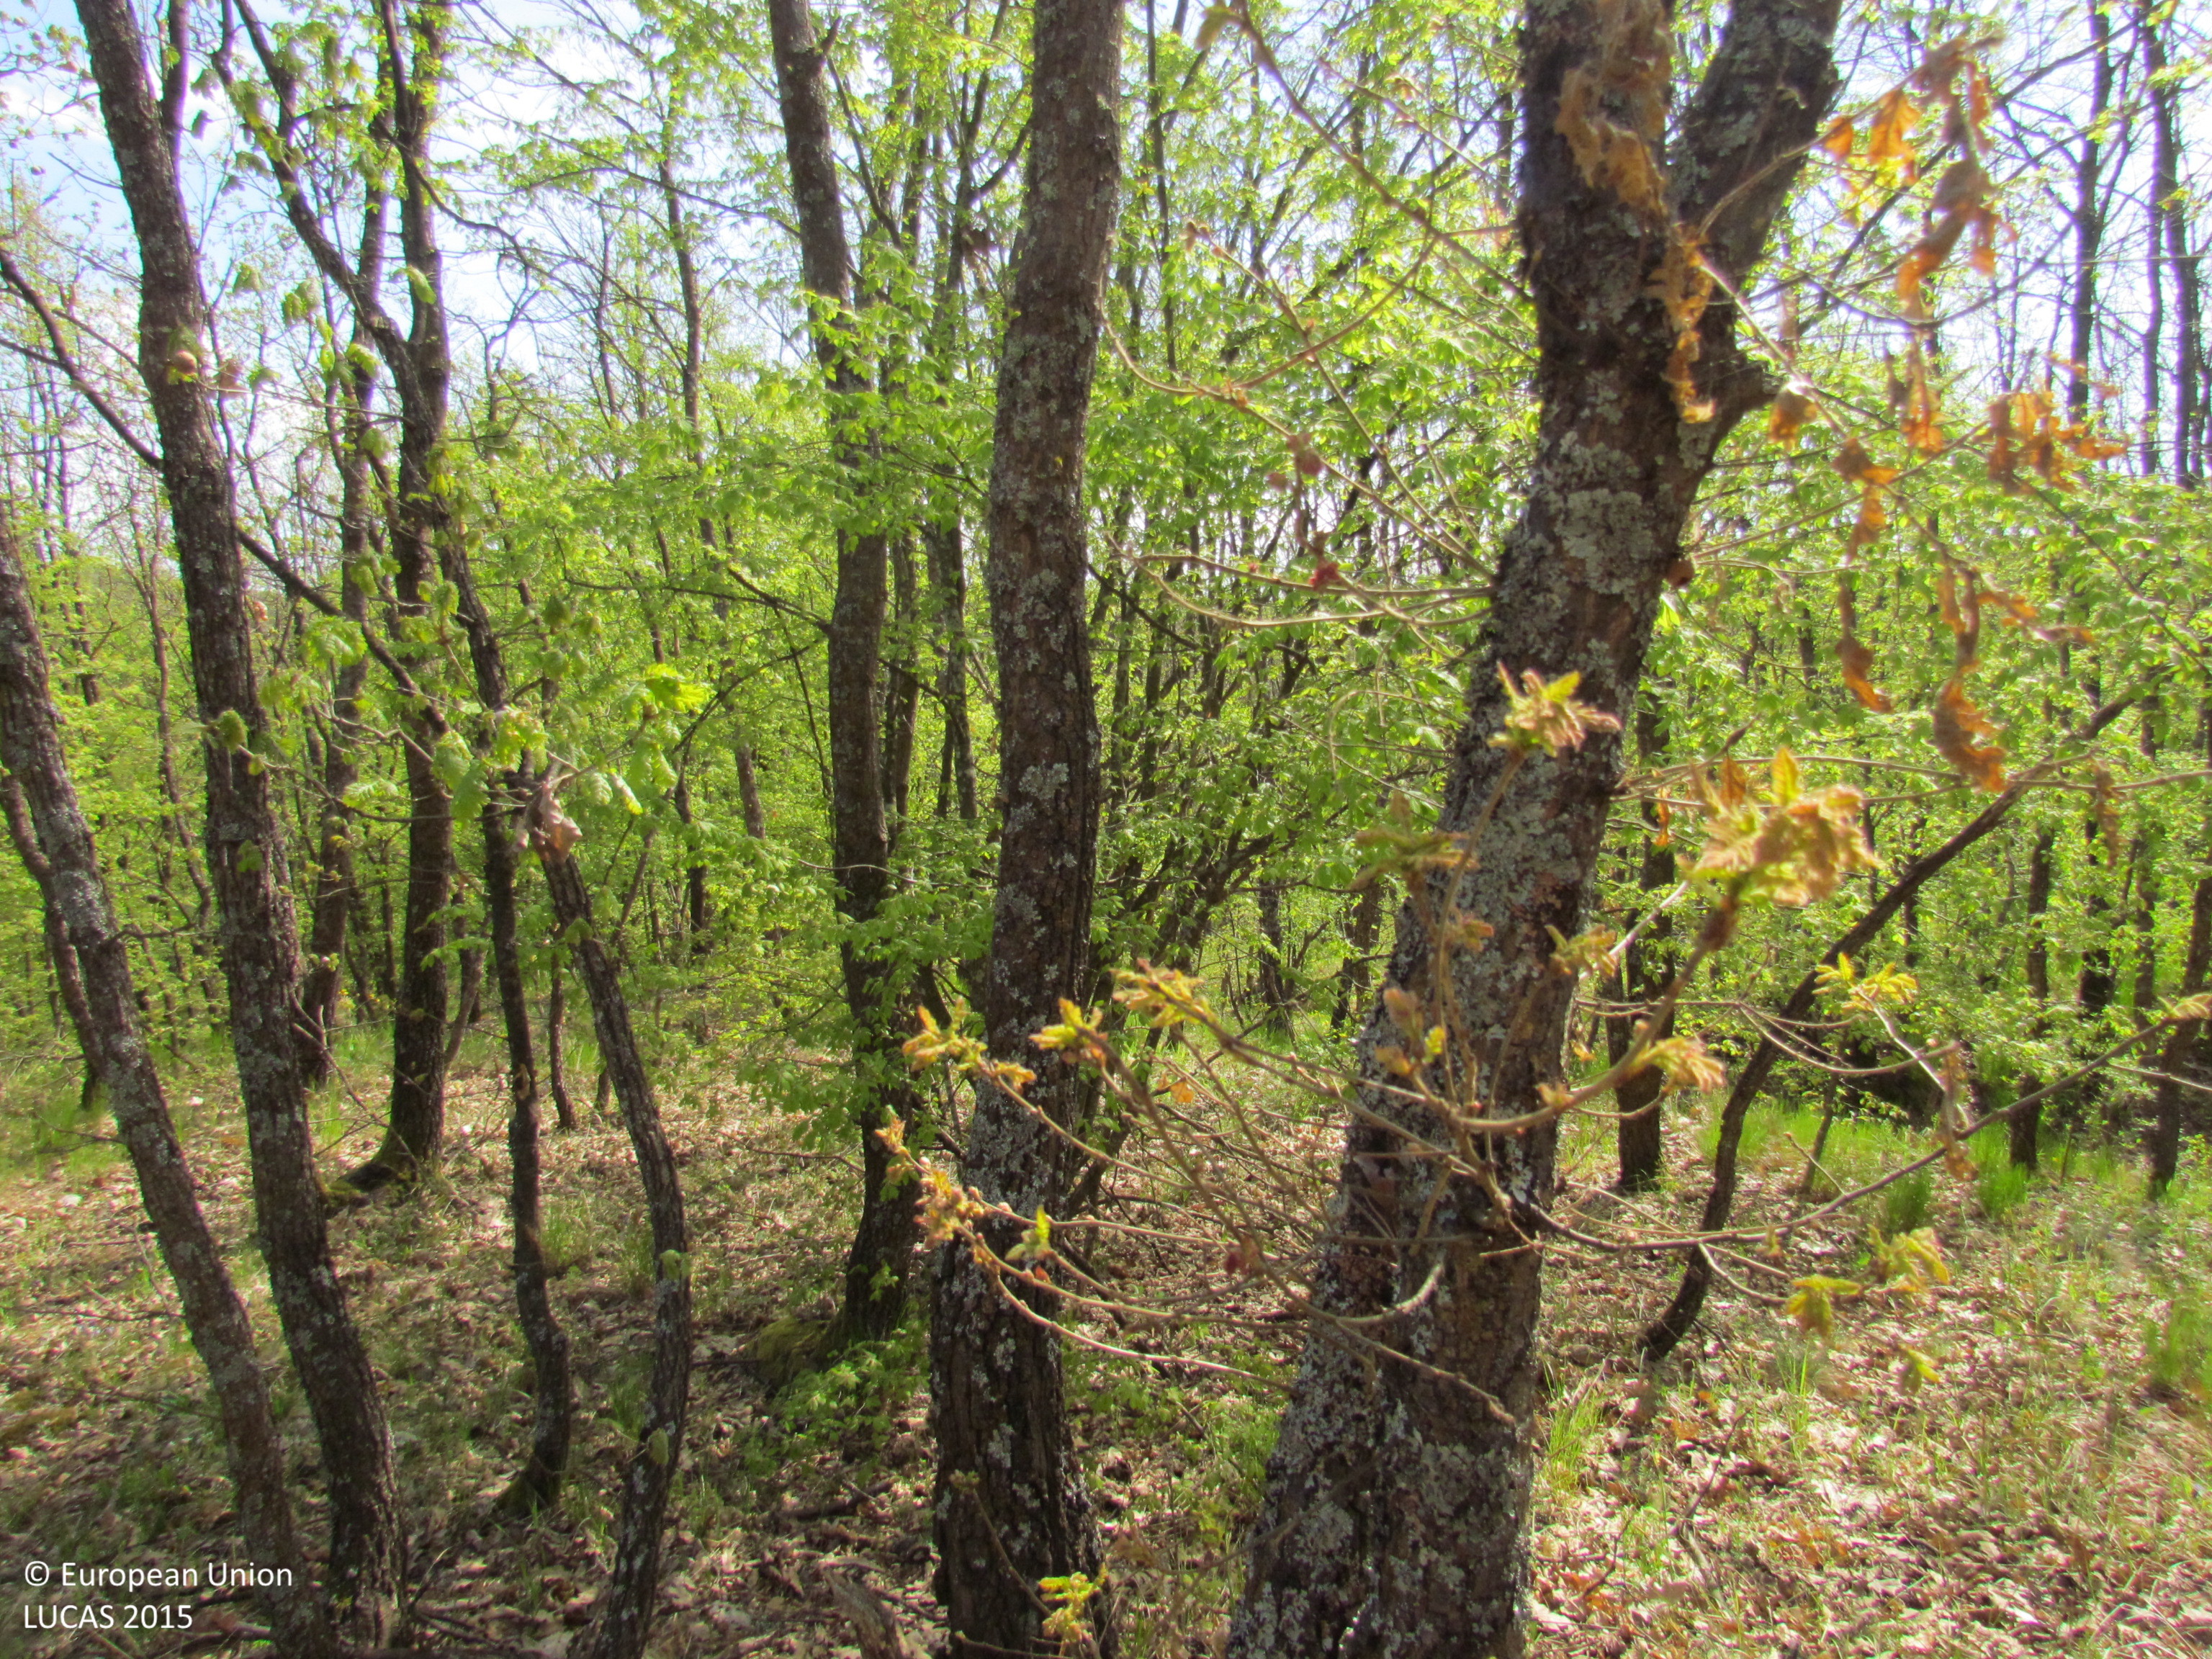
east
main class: Woodland
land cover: Broadleaved woodland
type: mesophytic deciduous forest
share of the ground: 50 - 75 %
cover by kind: broadleaved forest trees 70 %, consolidated bare surface 25 %, herbaceous plants 5 %
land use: Forestry
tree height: > 5 m
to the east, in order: Broadleaved woodland; Ditches and canals; Broadleaved woodland; Rivers and streams; Broadleaved woodland; Tracks; Broadleaved woodland
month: April
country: BG
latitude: 42.7834
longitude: 26.5881
